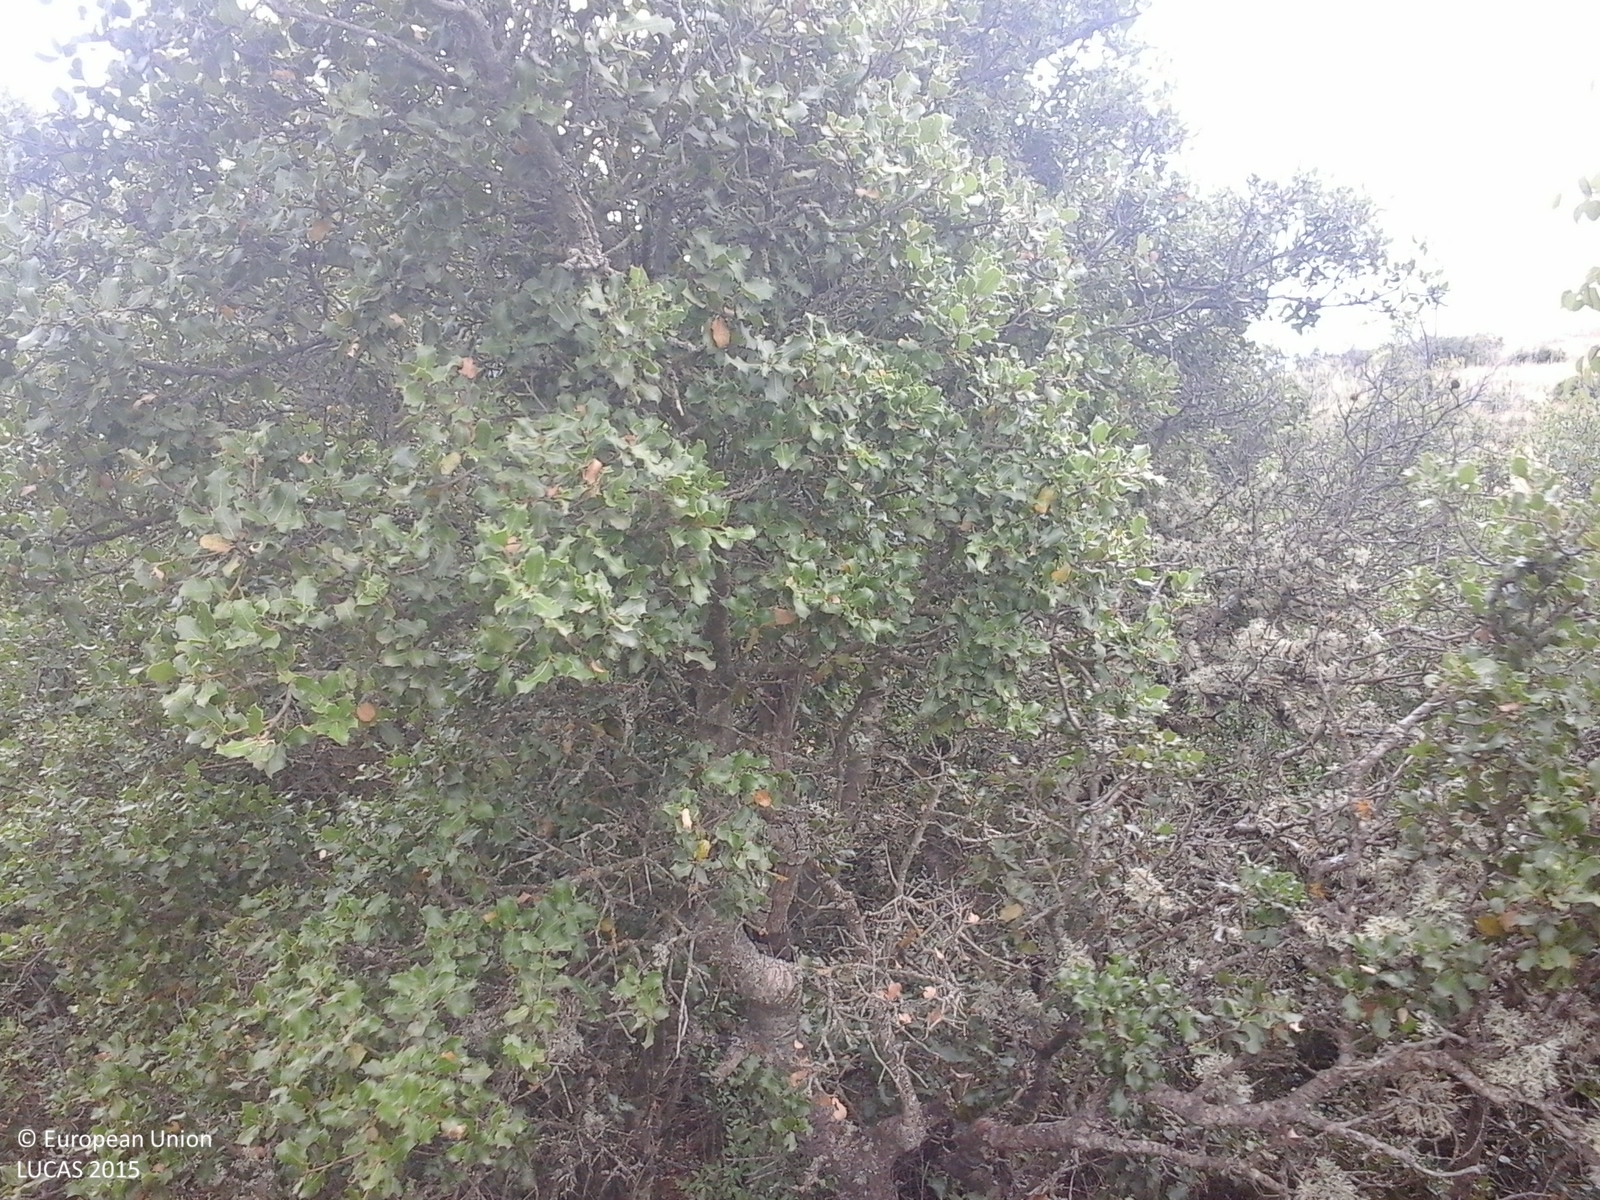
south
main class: Shrubland
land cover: Shrubland without tree cover
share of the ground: > 75 %
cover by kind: shrubs 80 %, herbaceous plants 20 %
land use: Semi-natural and natural areas not in use
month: June
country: GR
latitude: 40.7478
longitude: 23.1693
